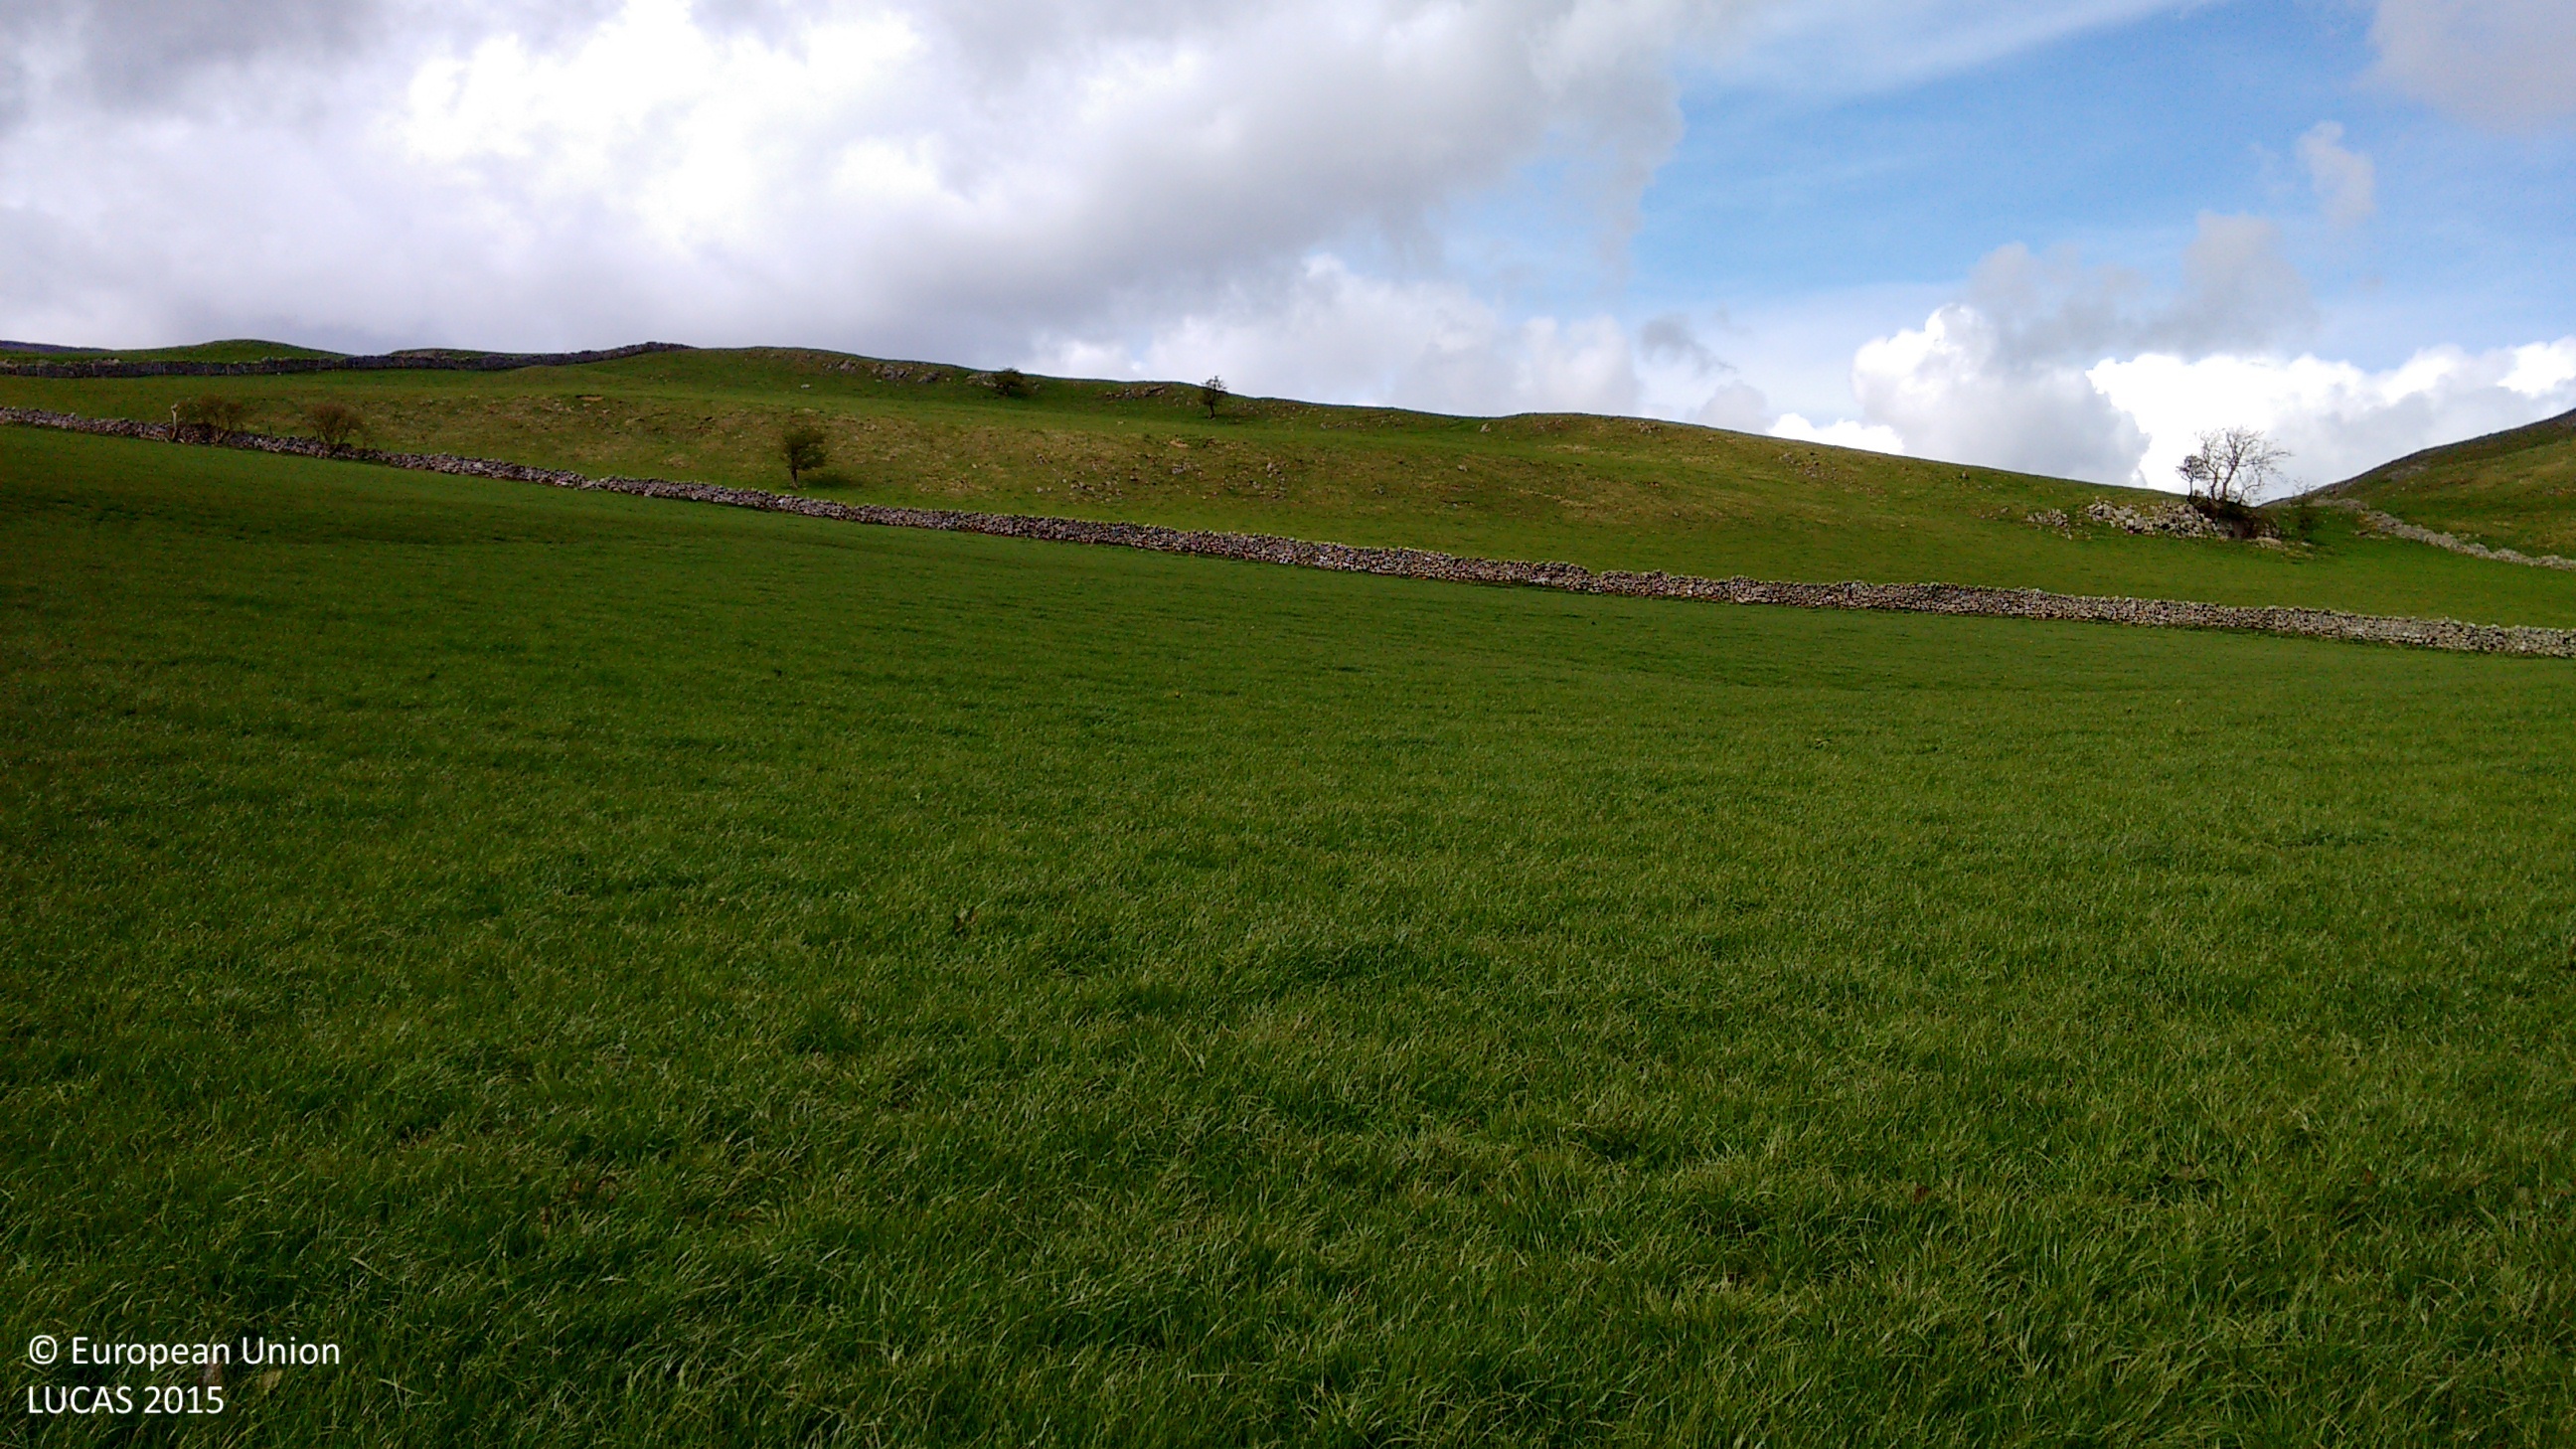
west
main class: Grassland
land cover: Grassland without tree/shrub cover
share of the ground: > 75 %
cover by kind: herbaceous plants 100 %
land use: Agriculture (excluding fallow land and kitchen gardens)
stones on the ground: < 10 %
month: April
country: GB
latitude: 53.9127
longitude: -2.5337
